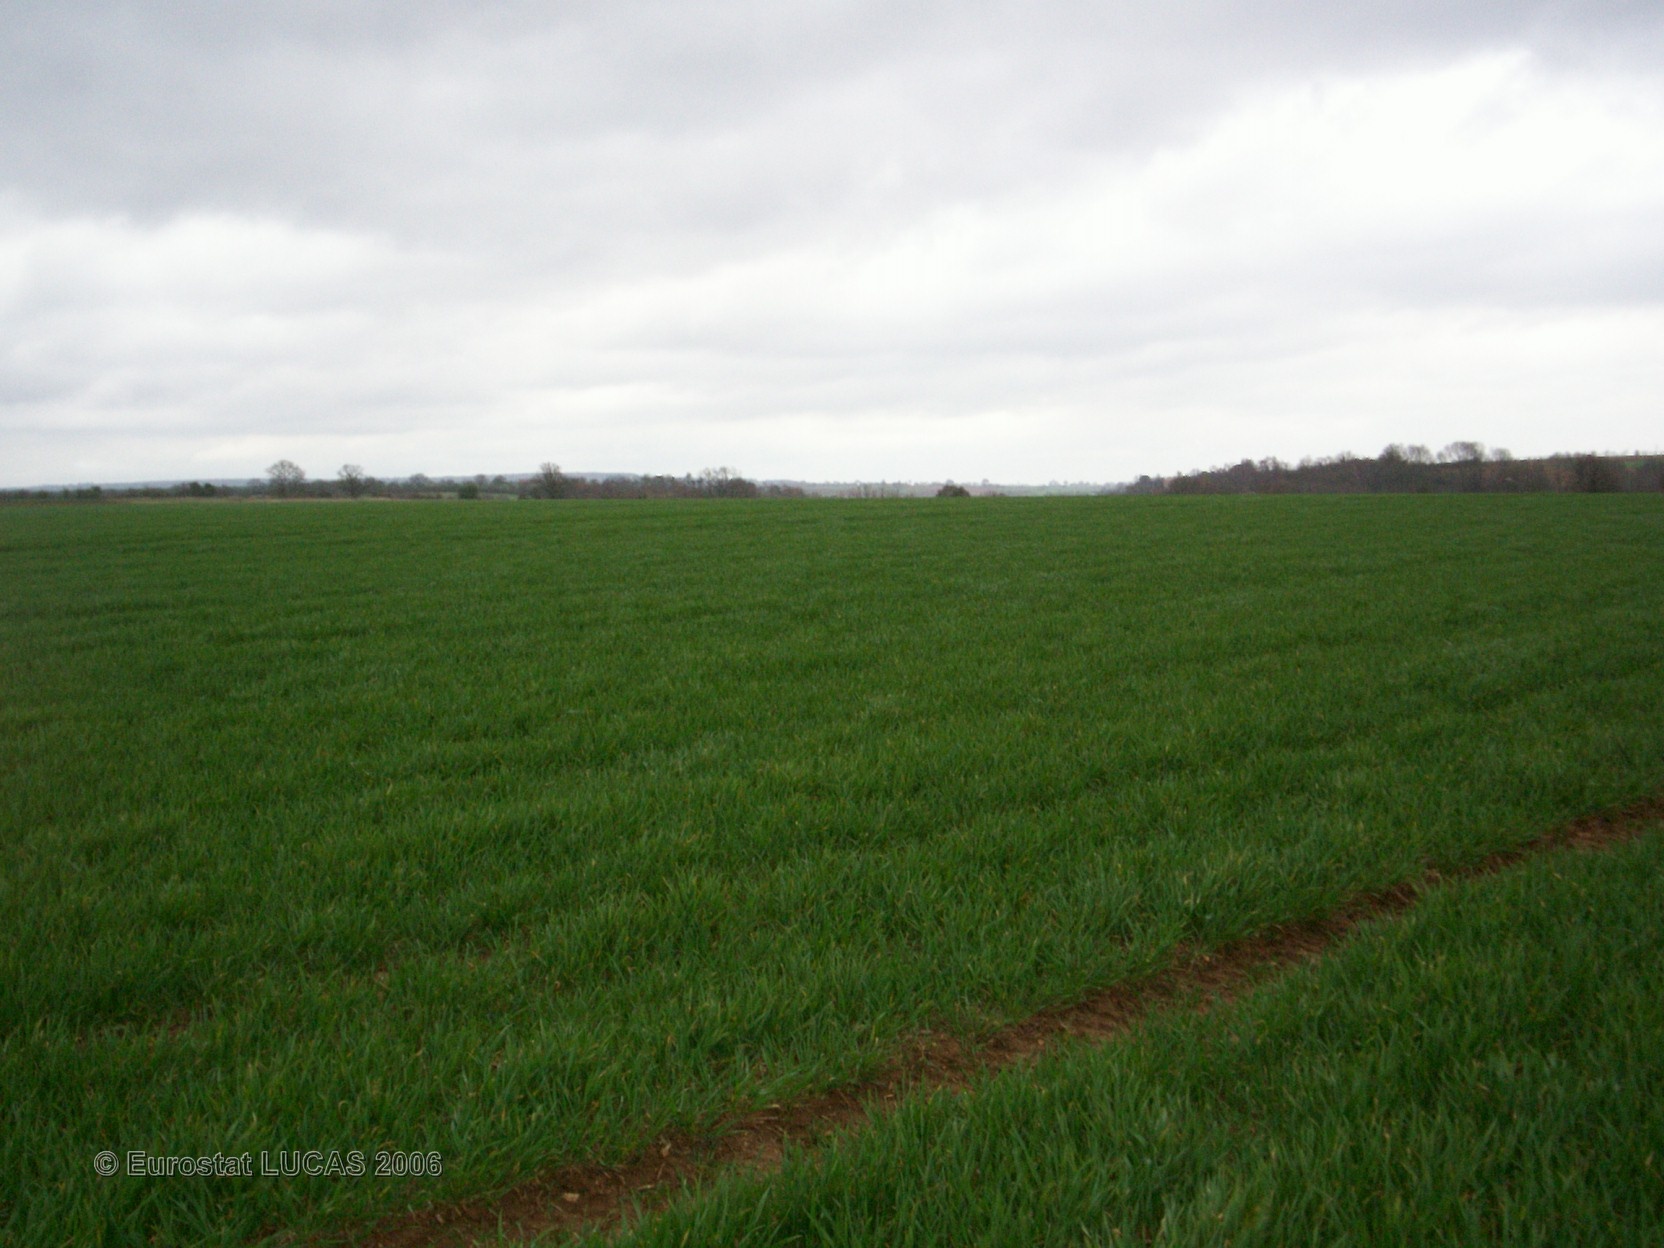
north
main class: Cropland
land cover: Common wheat
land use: Agriculture (excluding fallow land and kitchen gardens)
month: April
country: FR
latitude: 48.3587
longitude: 0.3241
